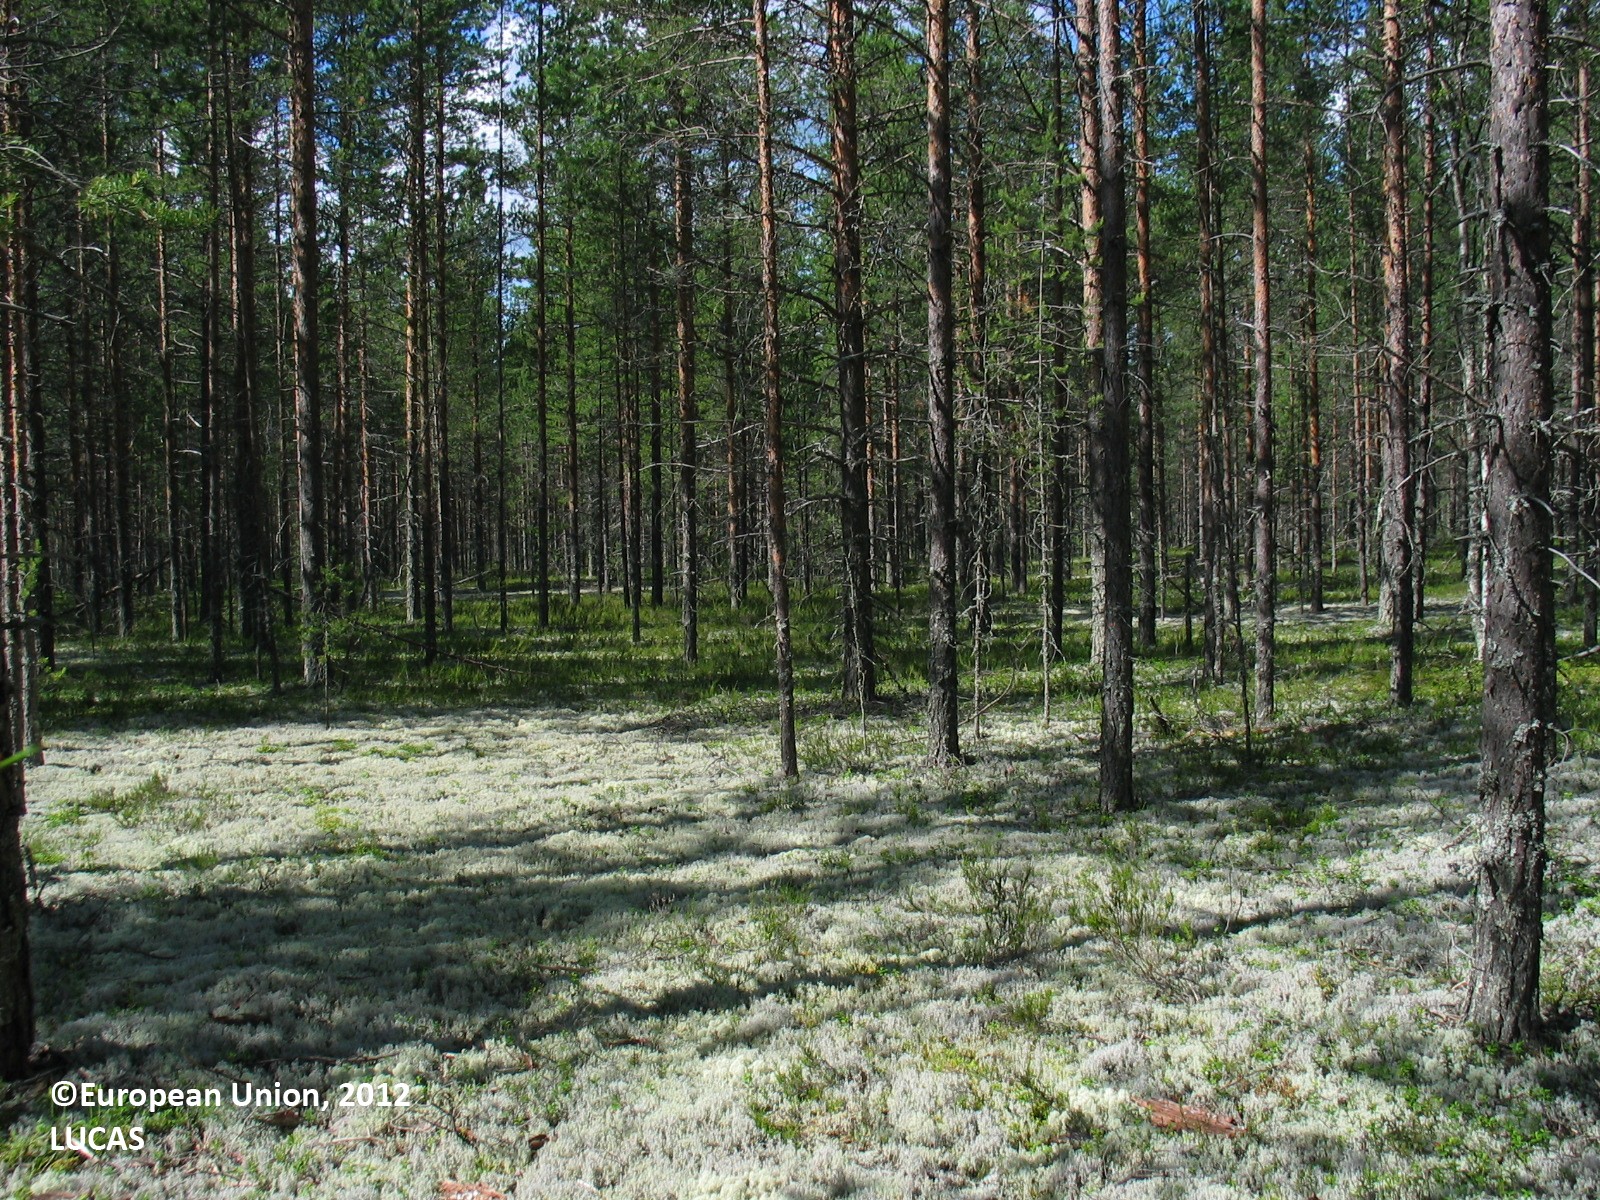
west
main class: Woodland
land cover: Pine dominated coniferous woodland
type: boreal forest
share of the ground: 25 - 50 %
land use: Amenities, museums, leisure
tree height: > 5 m
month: July
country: FI
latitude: 64.5860
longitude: 26.4648
